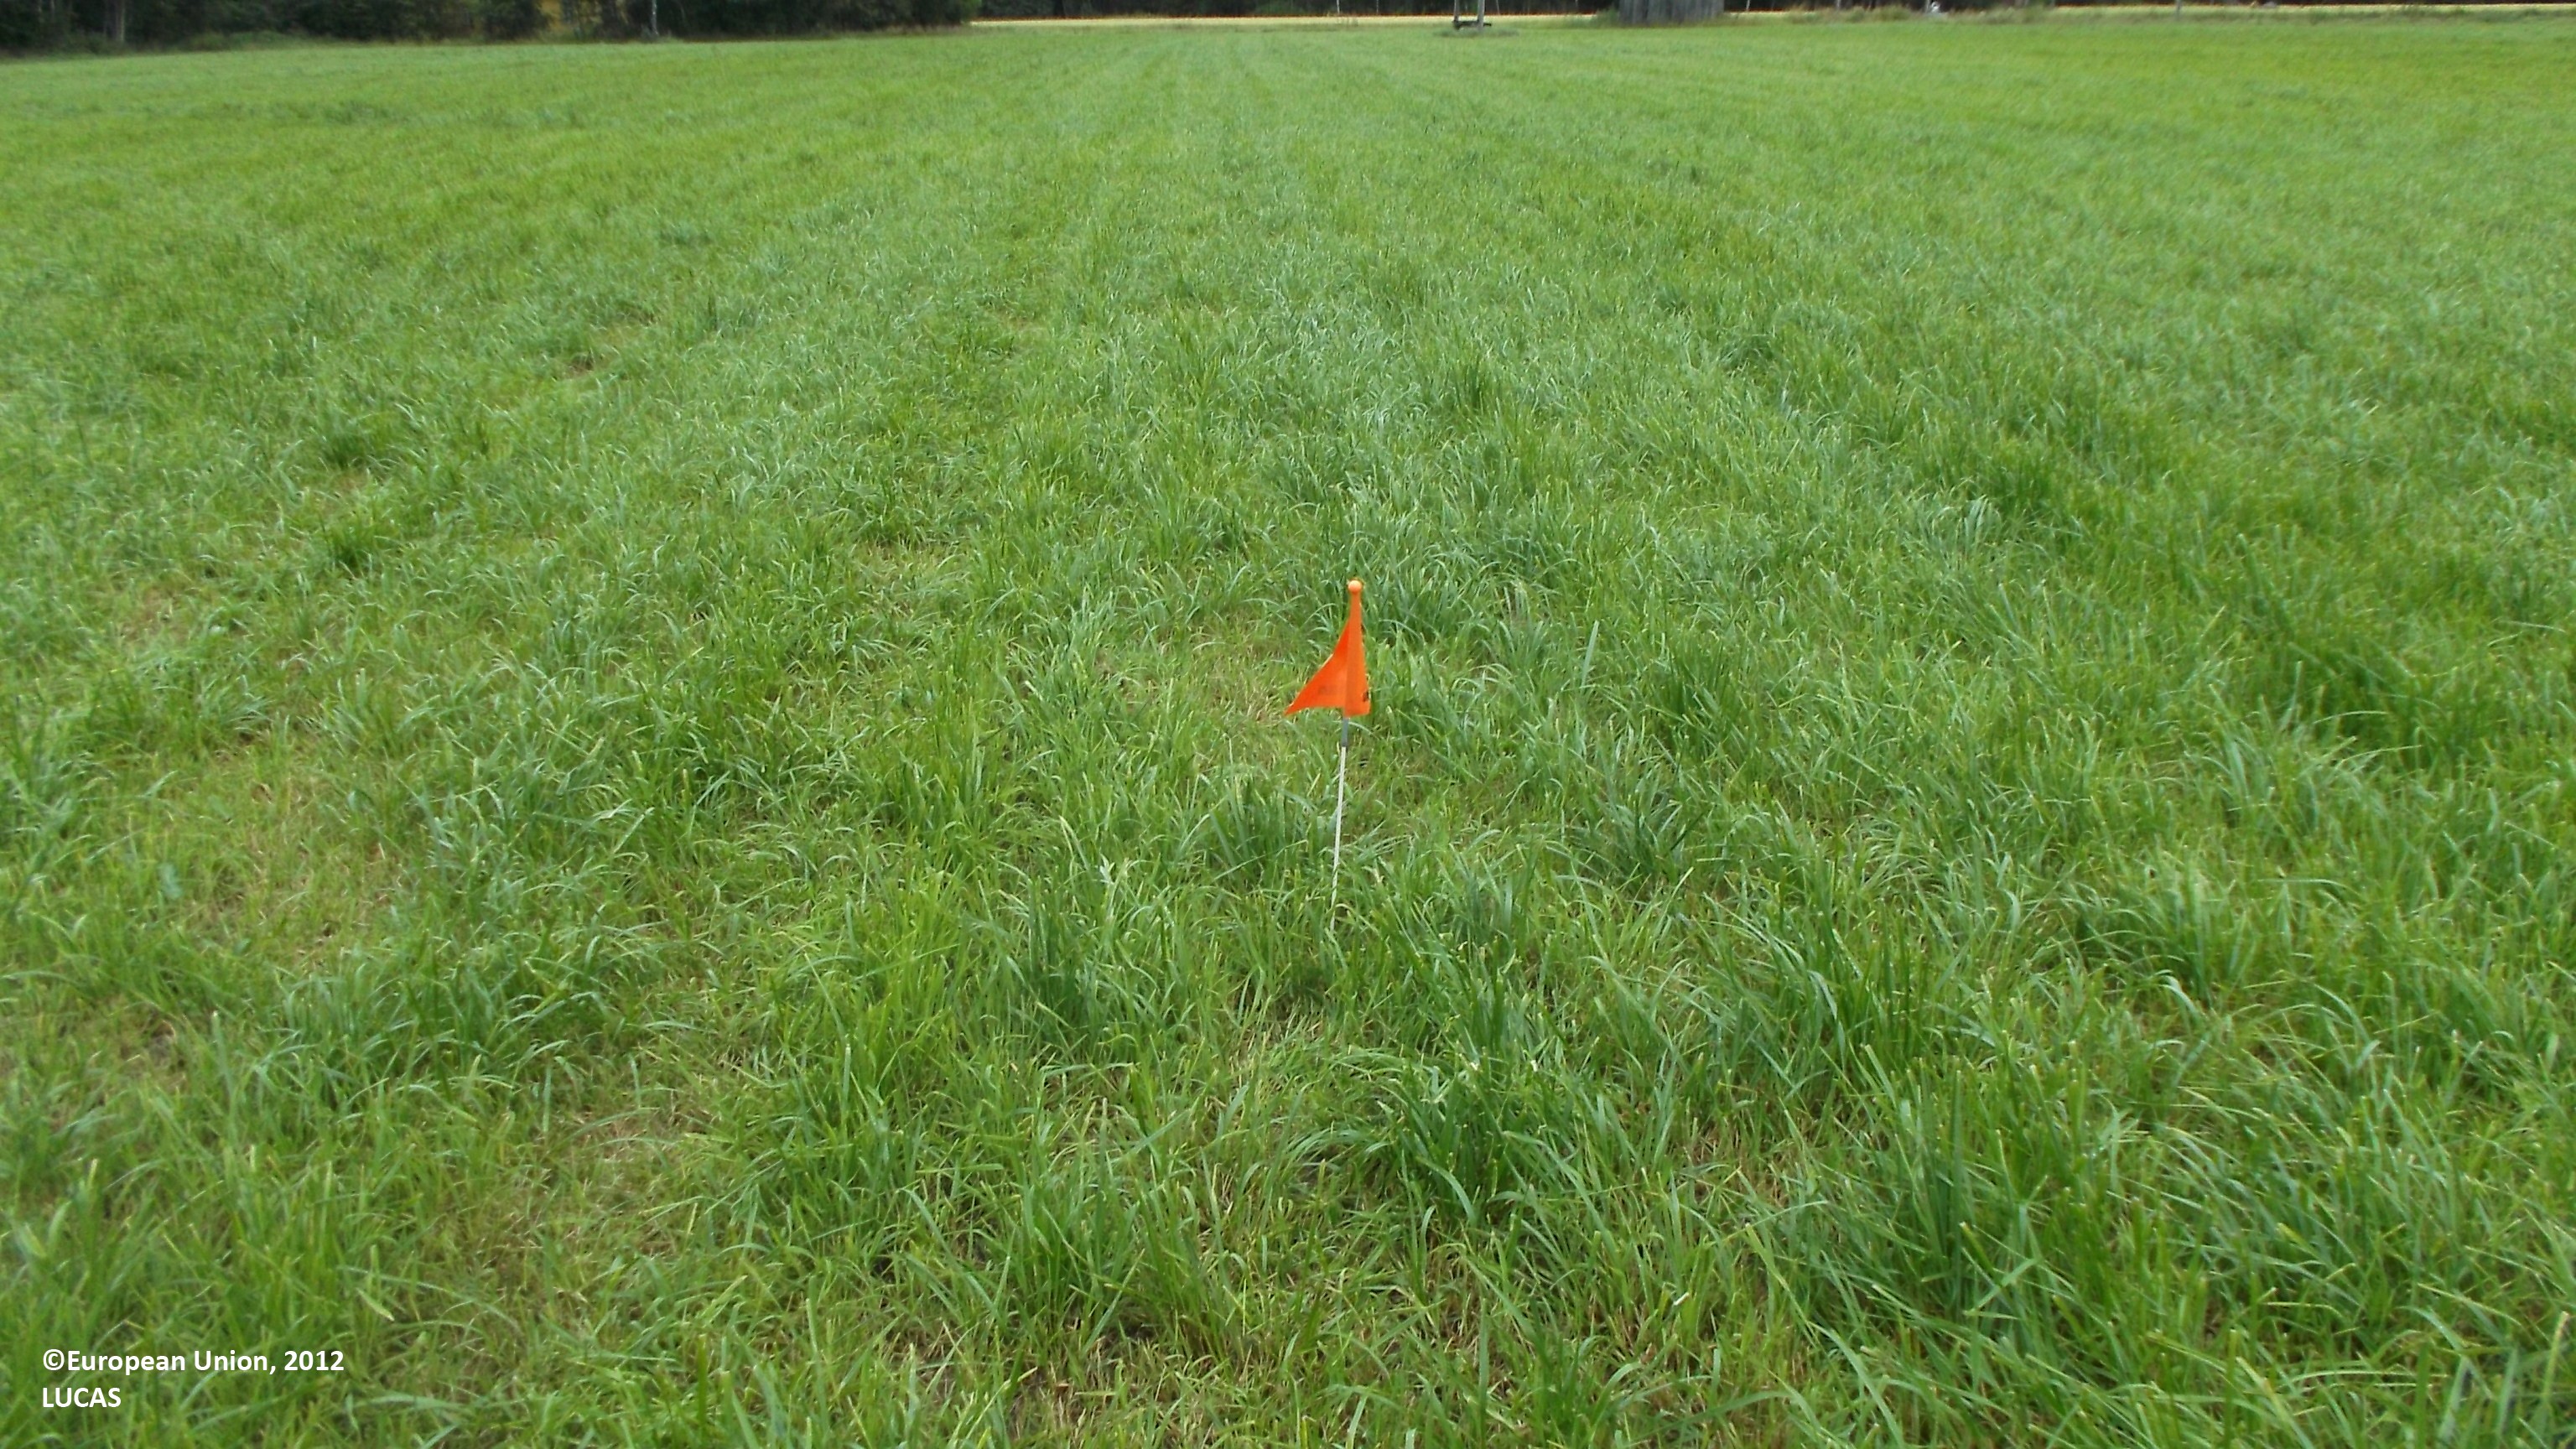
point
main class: Cropland
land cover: Temporary grasslands
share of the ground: > 75 %
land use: Agriculture (excluding fallow land and kitchen gardens)
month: August
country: FI
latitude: 64.0379
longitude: 23.5079
